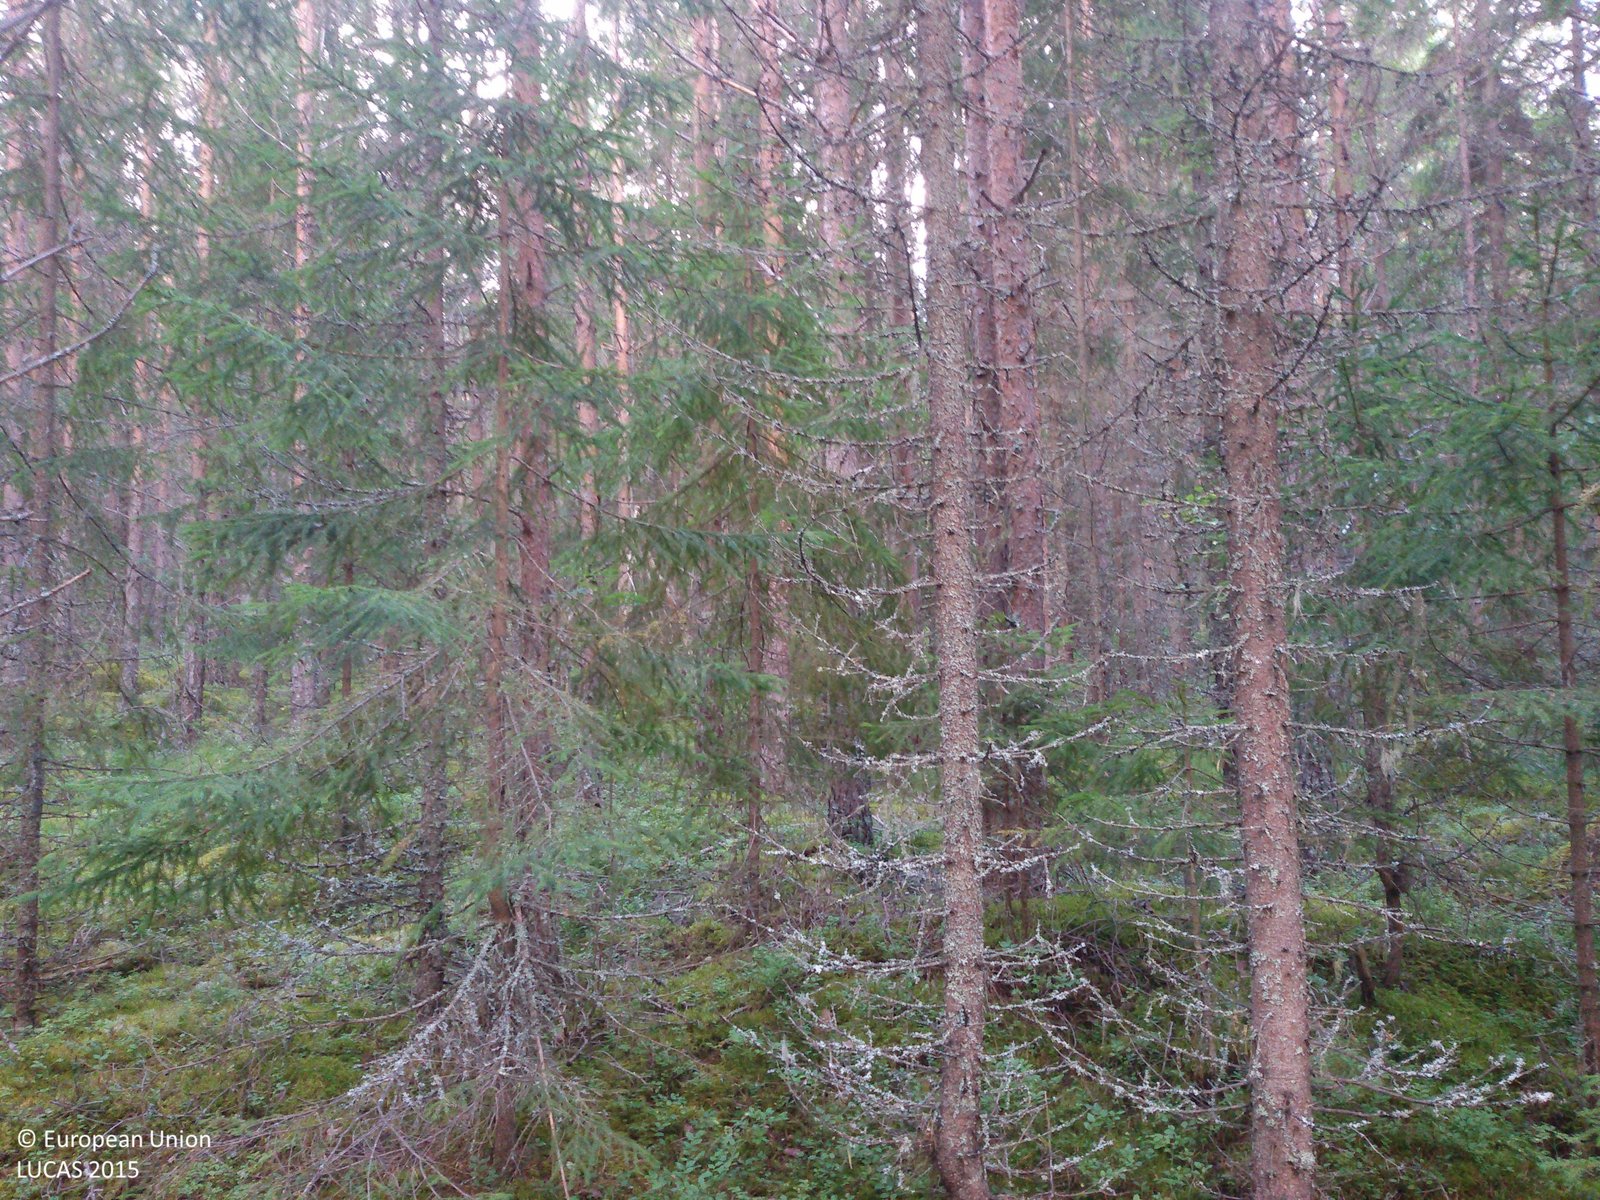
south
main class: Woodland
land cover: Pine dominated coniferous woodland
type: boreal forest
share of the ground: > 75 %
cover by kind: coniferous forest trees 80 %, shrubs 15 %, lichens and mosses 5 %
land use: Forestry
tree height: > 5 m
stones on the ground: 25 - 50 %
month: August
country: SE
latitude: 61.0181
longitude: 15.8137
